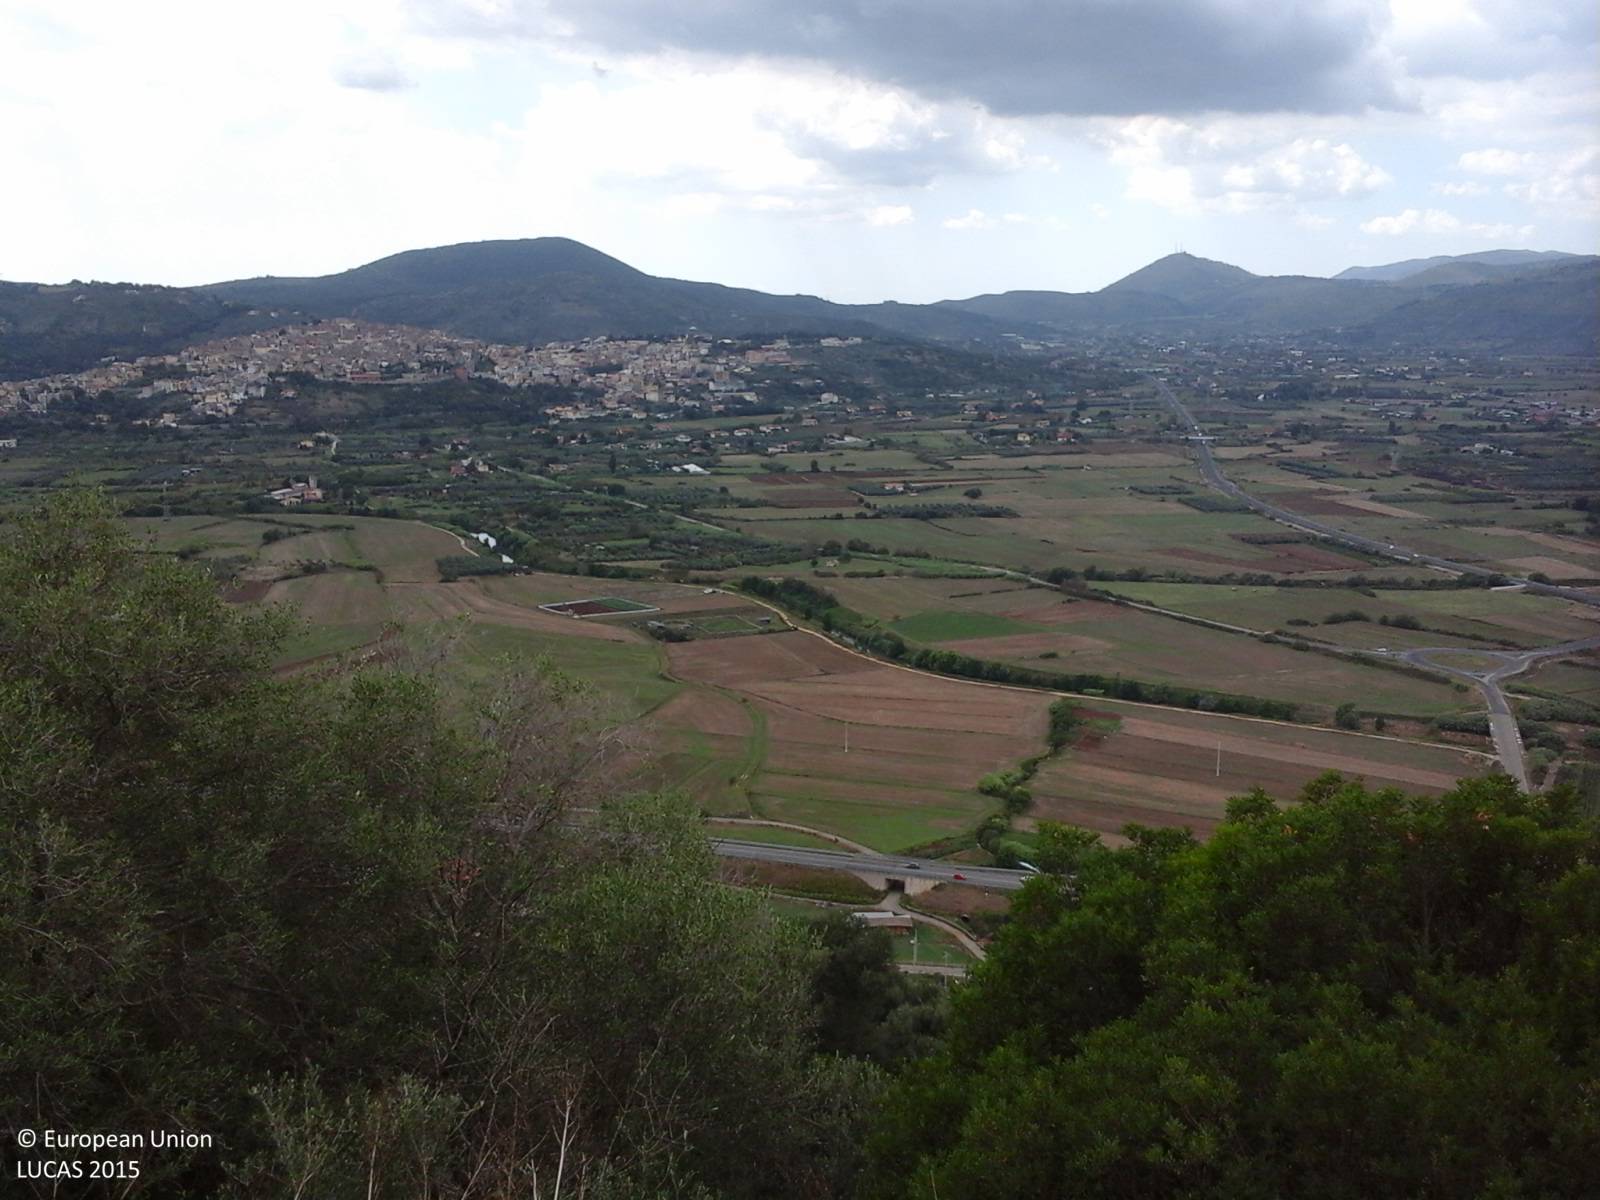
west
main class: Cropland
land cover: Olive groves
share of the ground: 25 - 50 %
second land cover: Grassland without tree/shrub cover
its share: 25 - 50 %
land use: Abandoned areas
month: August
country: IT
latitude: 41.4821
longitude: 13.2090
